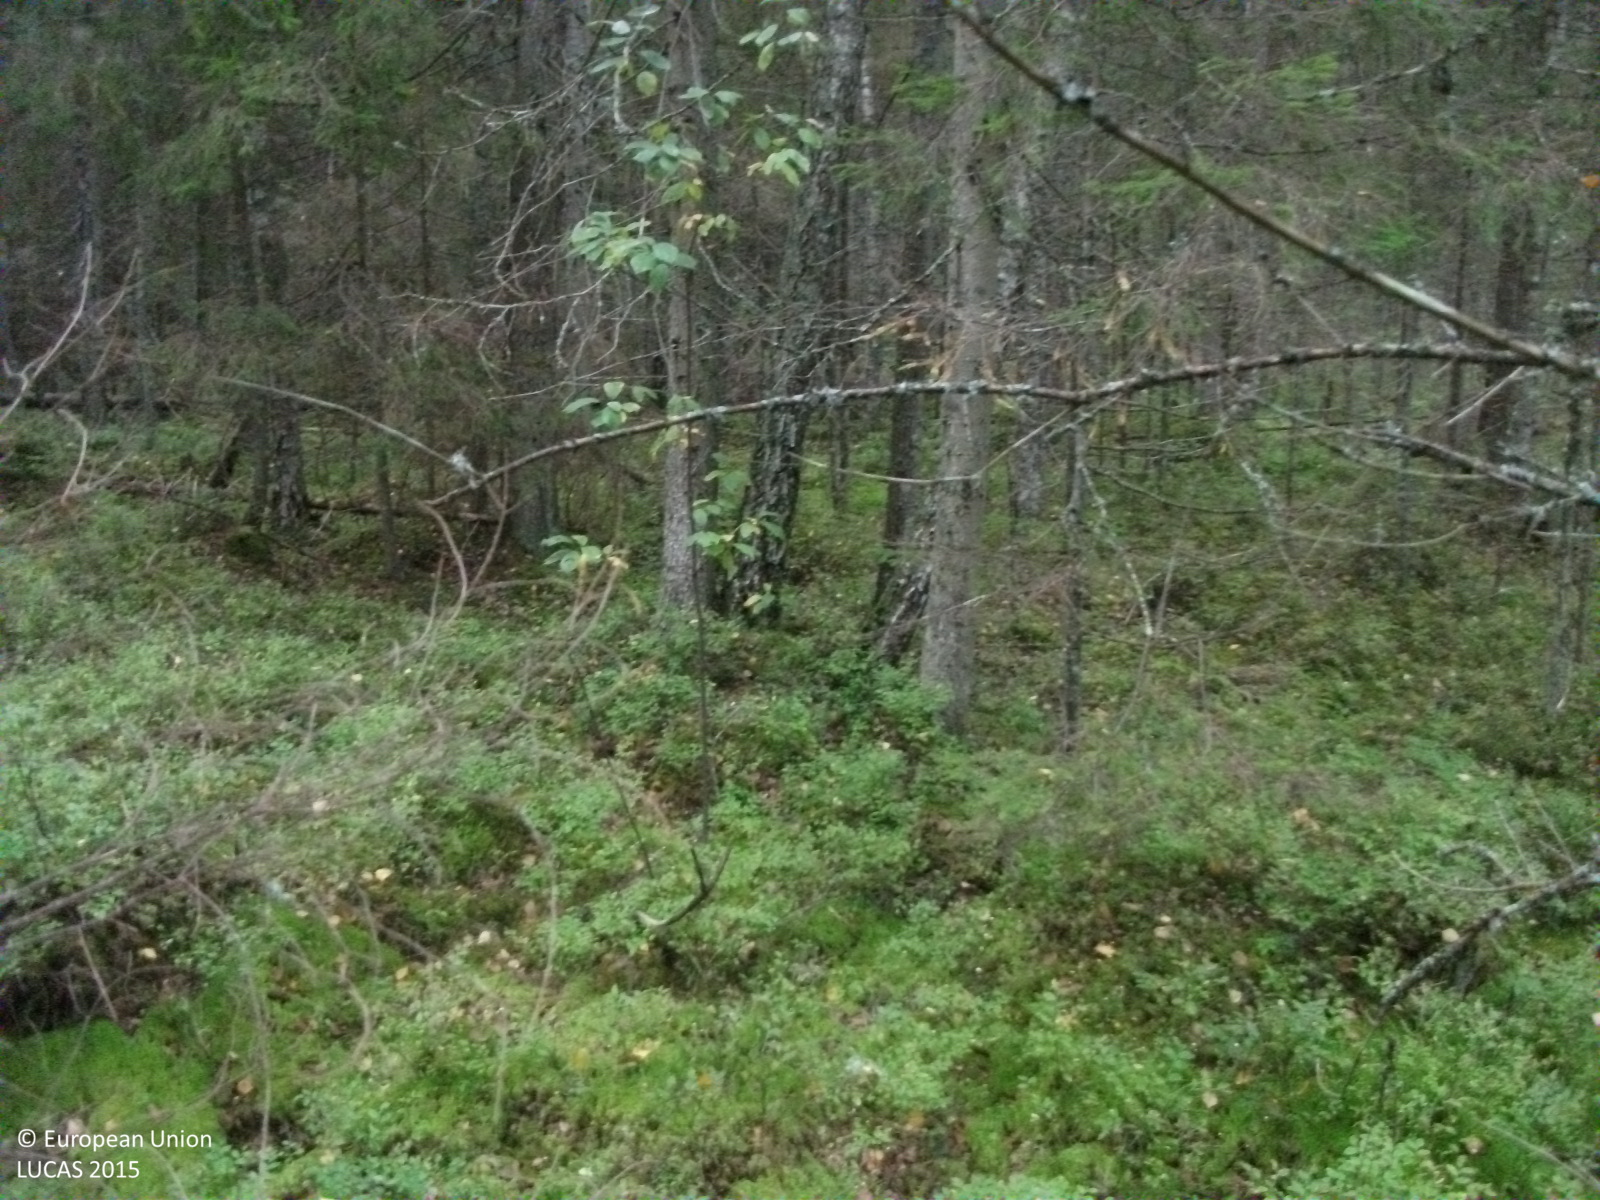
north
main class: Woodland
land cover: Spruce dominated coniferous woodland
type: hemiboreal forest and nemoral coniferous forest and mixed broadleaved-coniferous forest
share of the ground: > 75 %
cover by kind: coniferous forest trees 90 %, shrubs 5 %, lichens and mosses 5 %
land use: Forestry
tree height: > 5 m
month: September
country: LV
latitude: 57.9333
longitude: 24.5629
